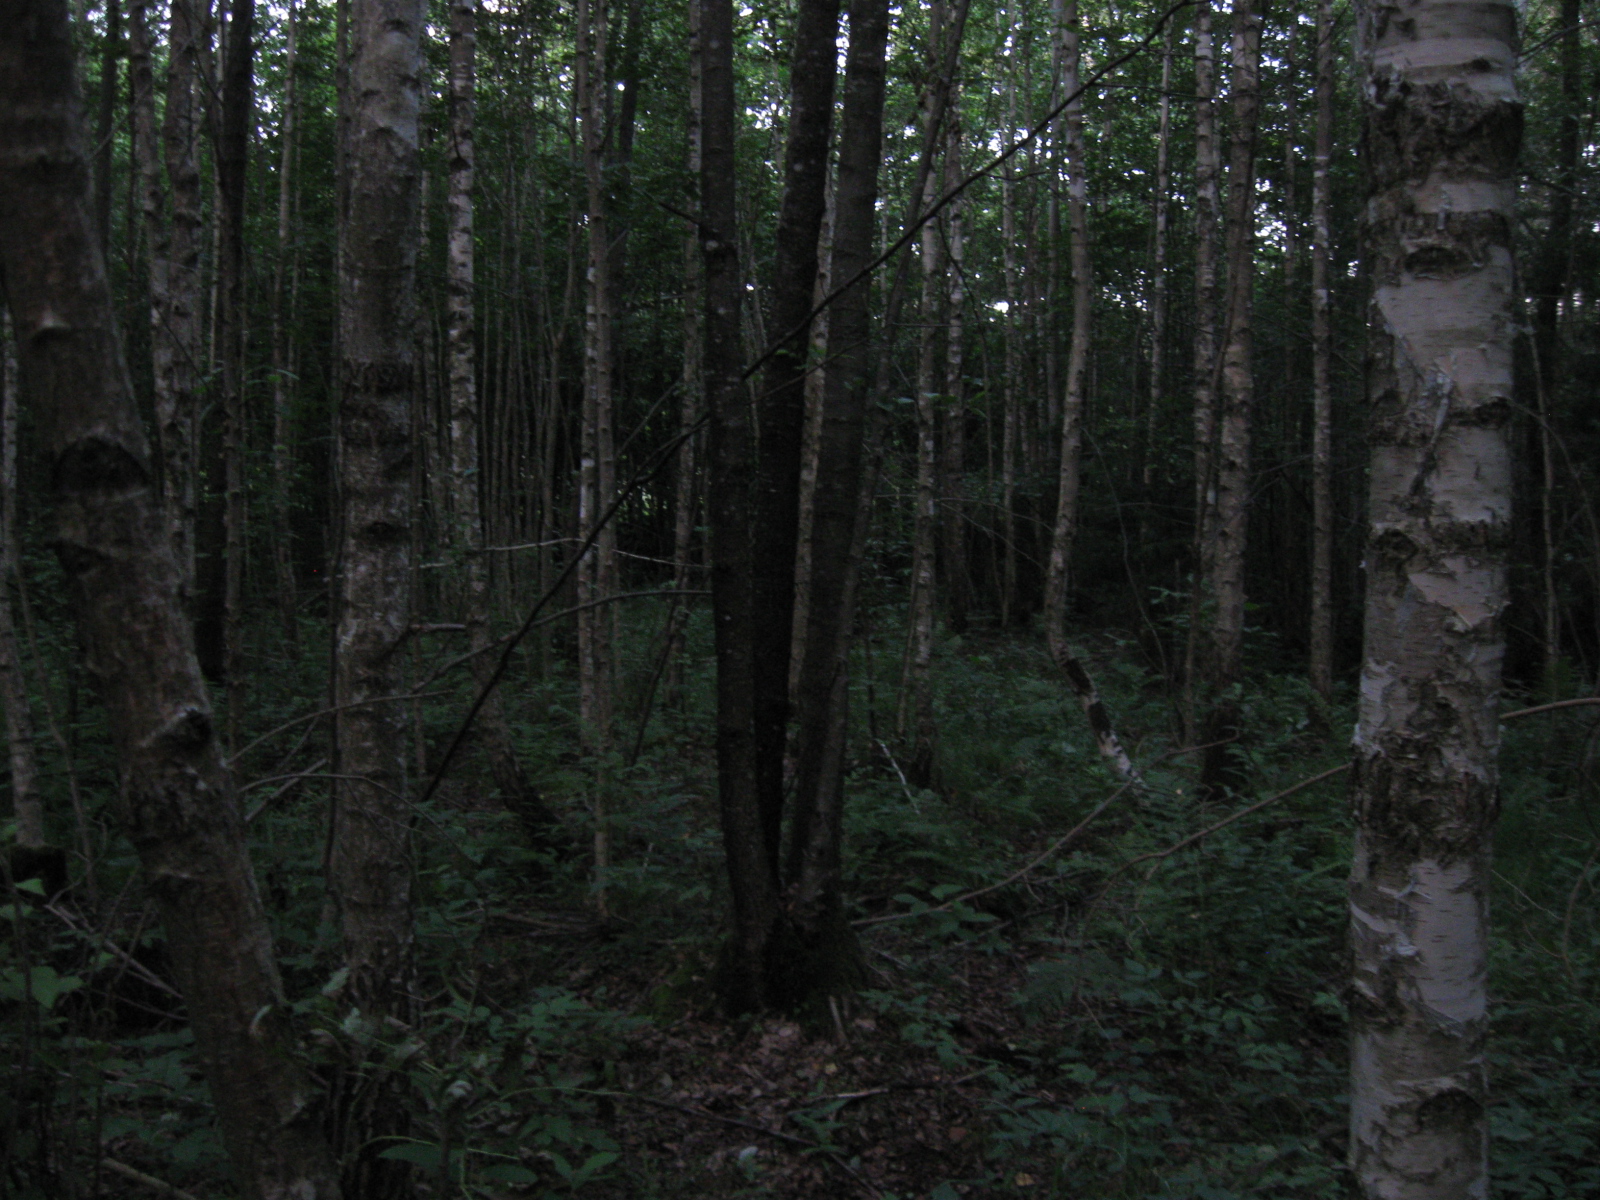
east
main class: Woodland
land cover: Broadleaved woodland
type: non-riverine alder, birch or aspen forest
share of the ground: > 75 %
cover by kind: broadleaved forest trees 85 %, herbaceous plants 10 %, shrubs 5 %
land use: Forestry
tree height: > 5 m
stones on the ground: < 10 %
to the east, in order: Broadleaved woodland; Spruce dominated mixed woodland; Broadleaved woodland
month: July
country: LT
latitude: 55.0866
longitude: 23.6668
